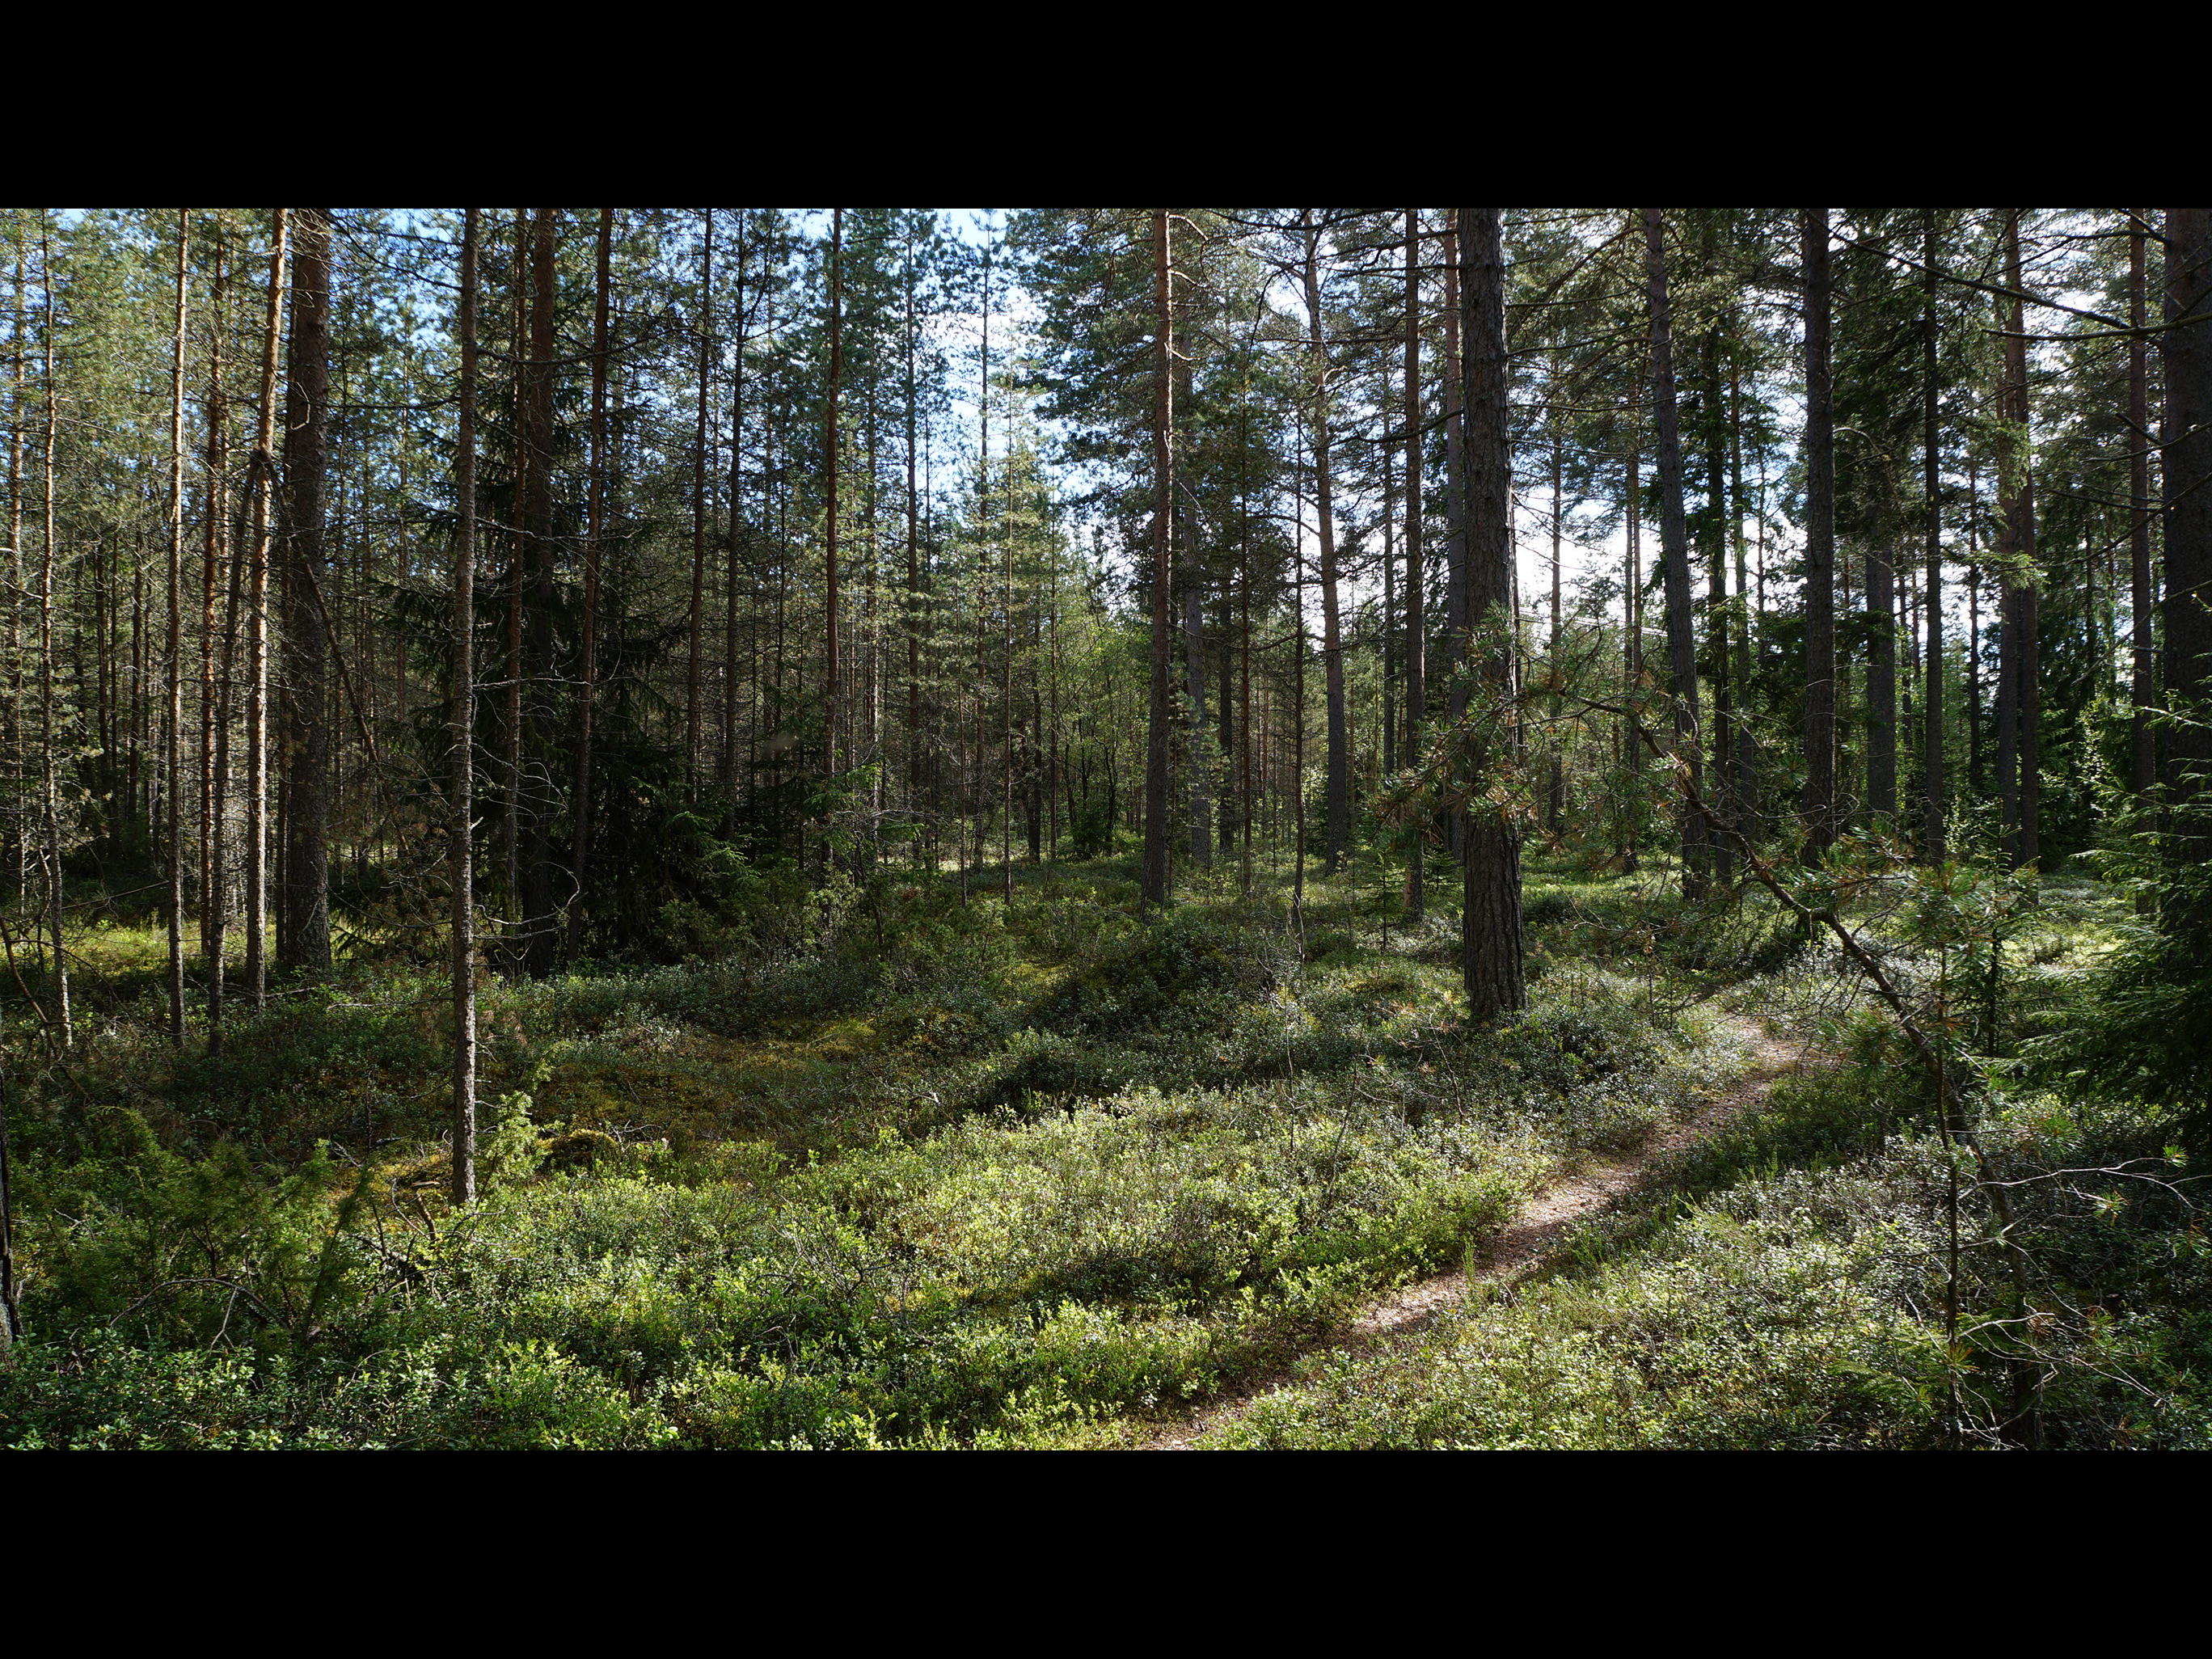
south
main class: Woodland
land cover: Pine dominated coniferous woodland
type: boreal forest
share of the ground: 50 - 75 %
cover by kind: coniferous forest trees 70 %, herbaceous plants 15 %, broadleaved forest trees 5 %, shrubs 5 %, lichens and mosses 5 %
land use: Forestry
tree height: > 5 m
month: June
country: FI
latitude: 64.2461
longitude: 23.8601
